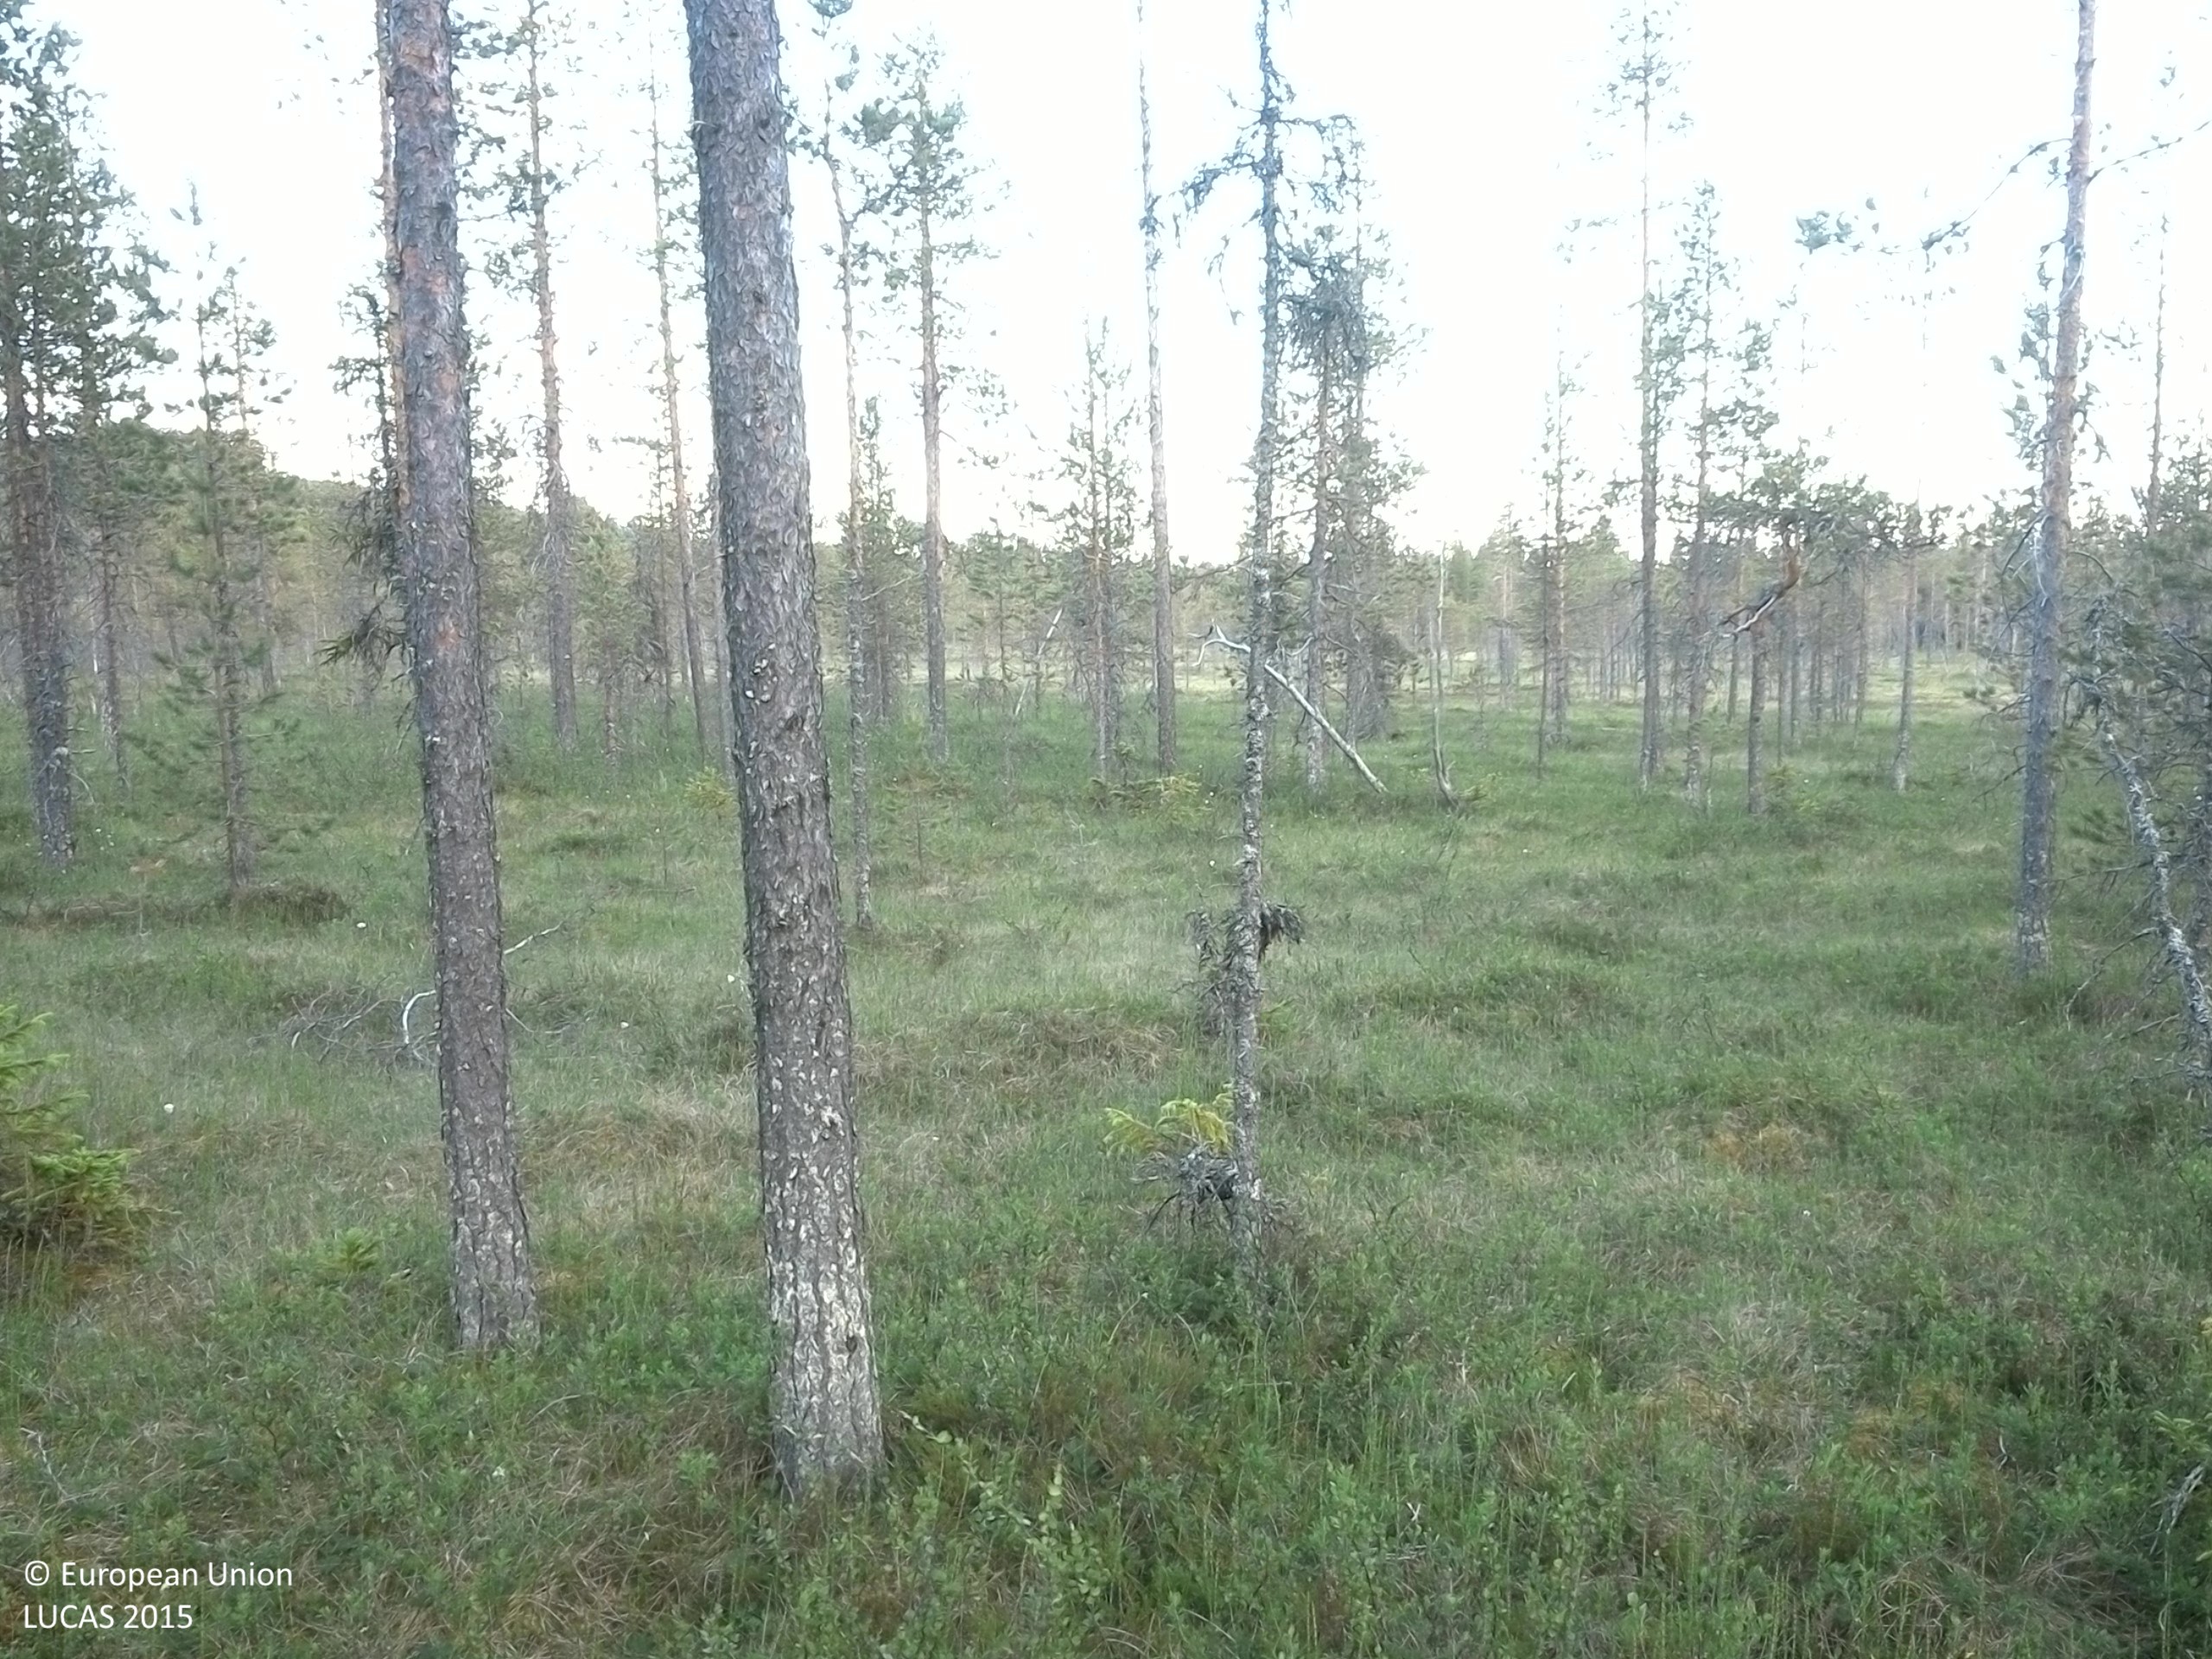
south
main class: Woodland
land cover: Pine dominated coniferous woodland
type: mire and swamp forests
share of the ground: 10 - 25 %
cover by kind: shrubs 55 %, lichens and mosses 20 %, herbaceous plants 15 %, coniferous forest trees 10 %
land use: Semi-natural and natural areas not in use
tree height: > 5 m
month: July
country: SE
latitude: 64.0713
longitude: 16.7960
